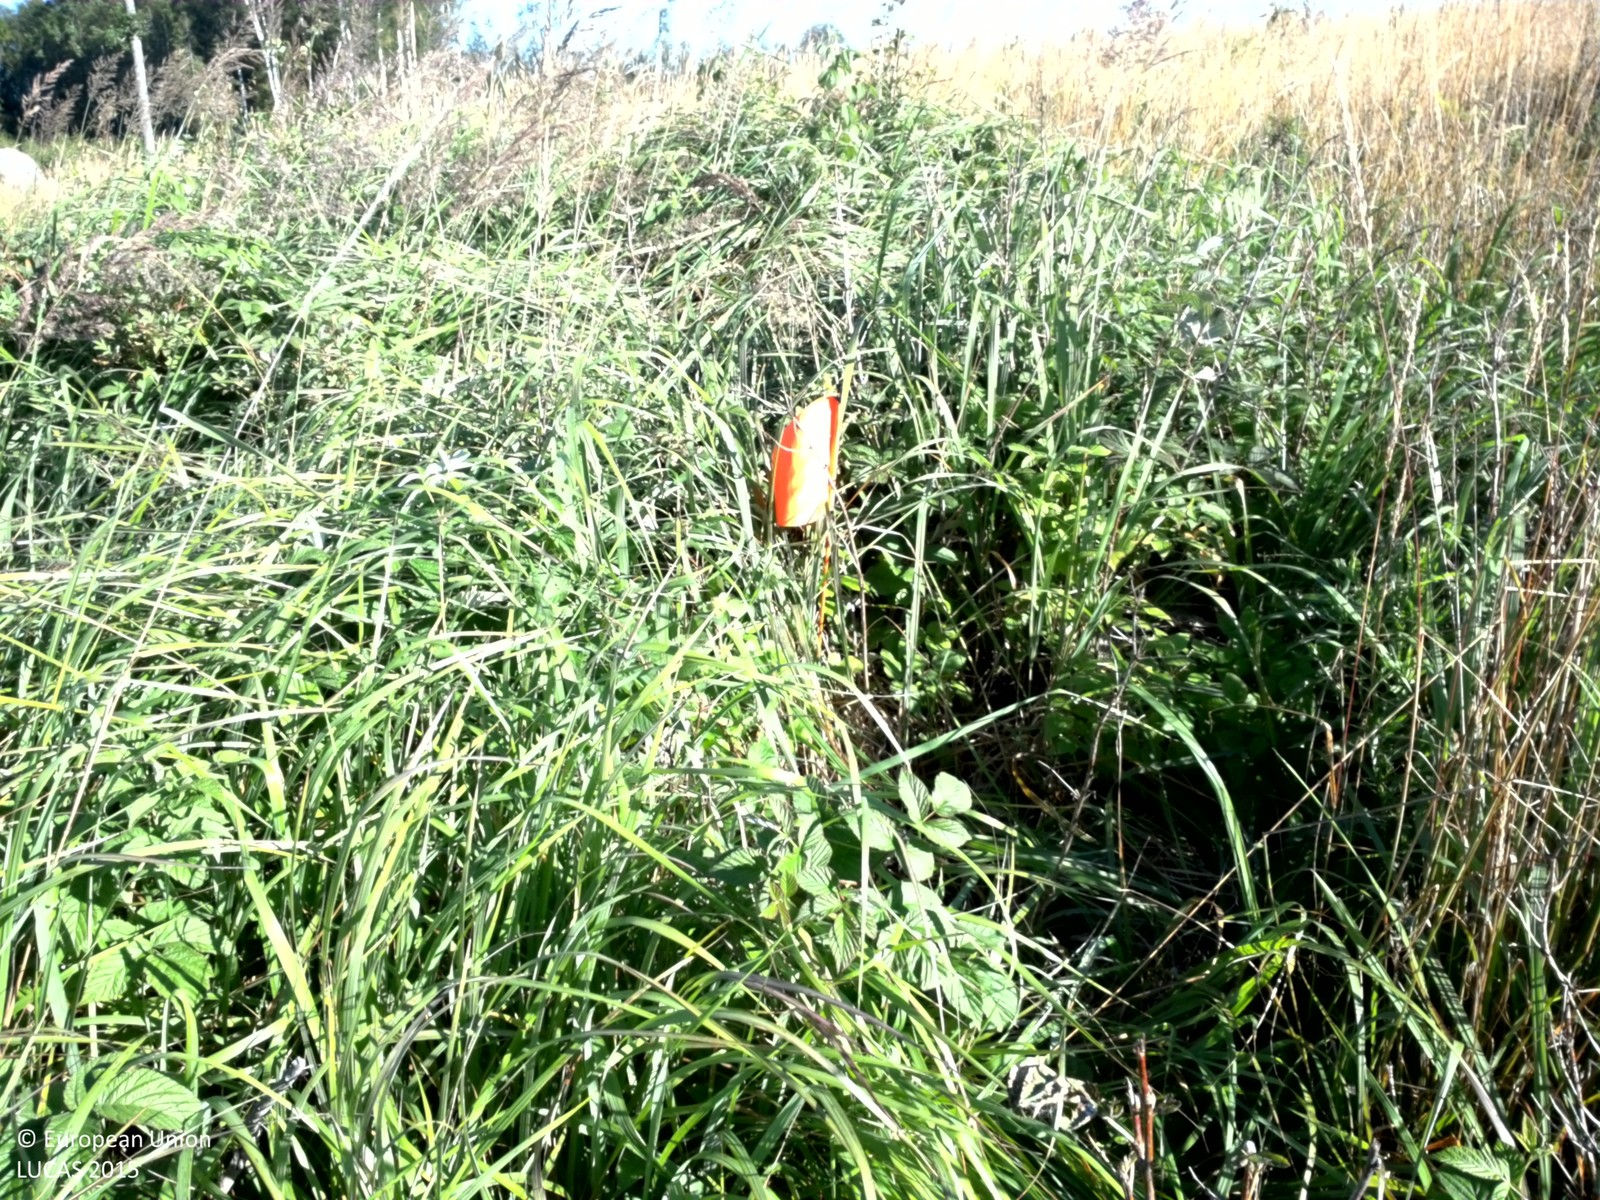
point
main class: Grassland
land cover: Grassland without tree/shrub cover
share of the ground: > 75 %
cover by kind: herbaceous plants 100 %
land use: Forestry
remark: Clear cut
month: August
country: SE
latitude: 60.1104
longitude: 17.0976
